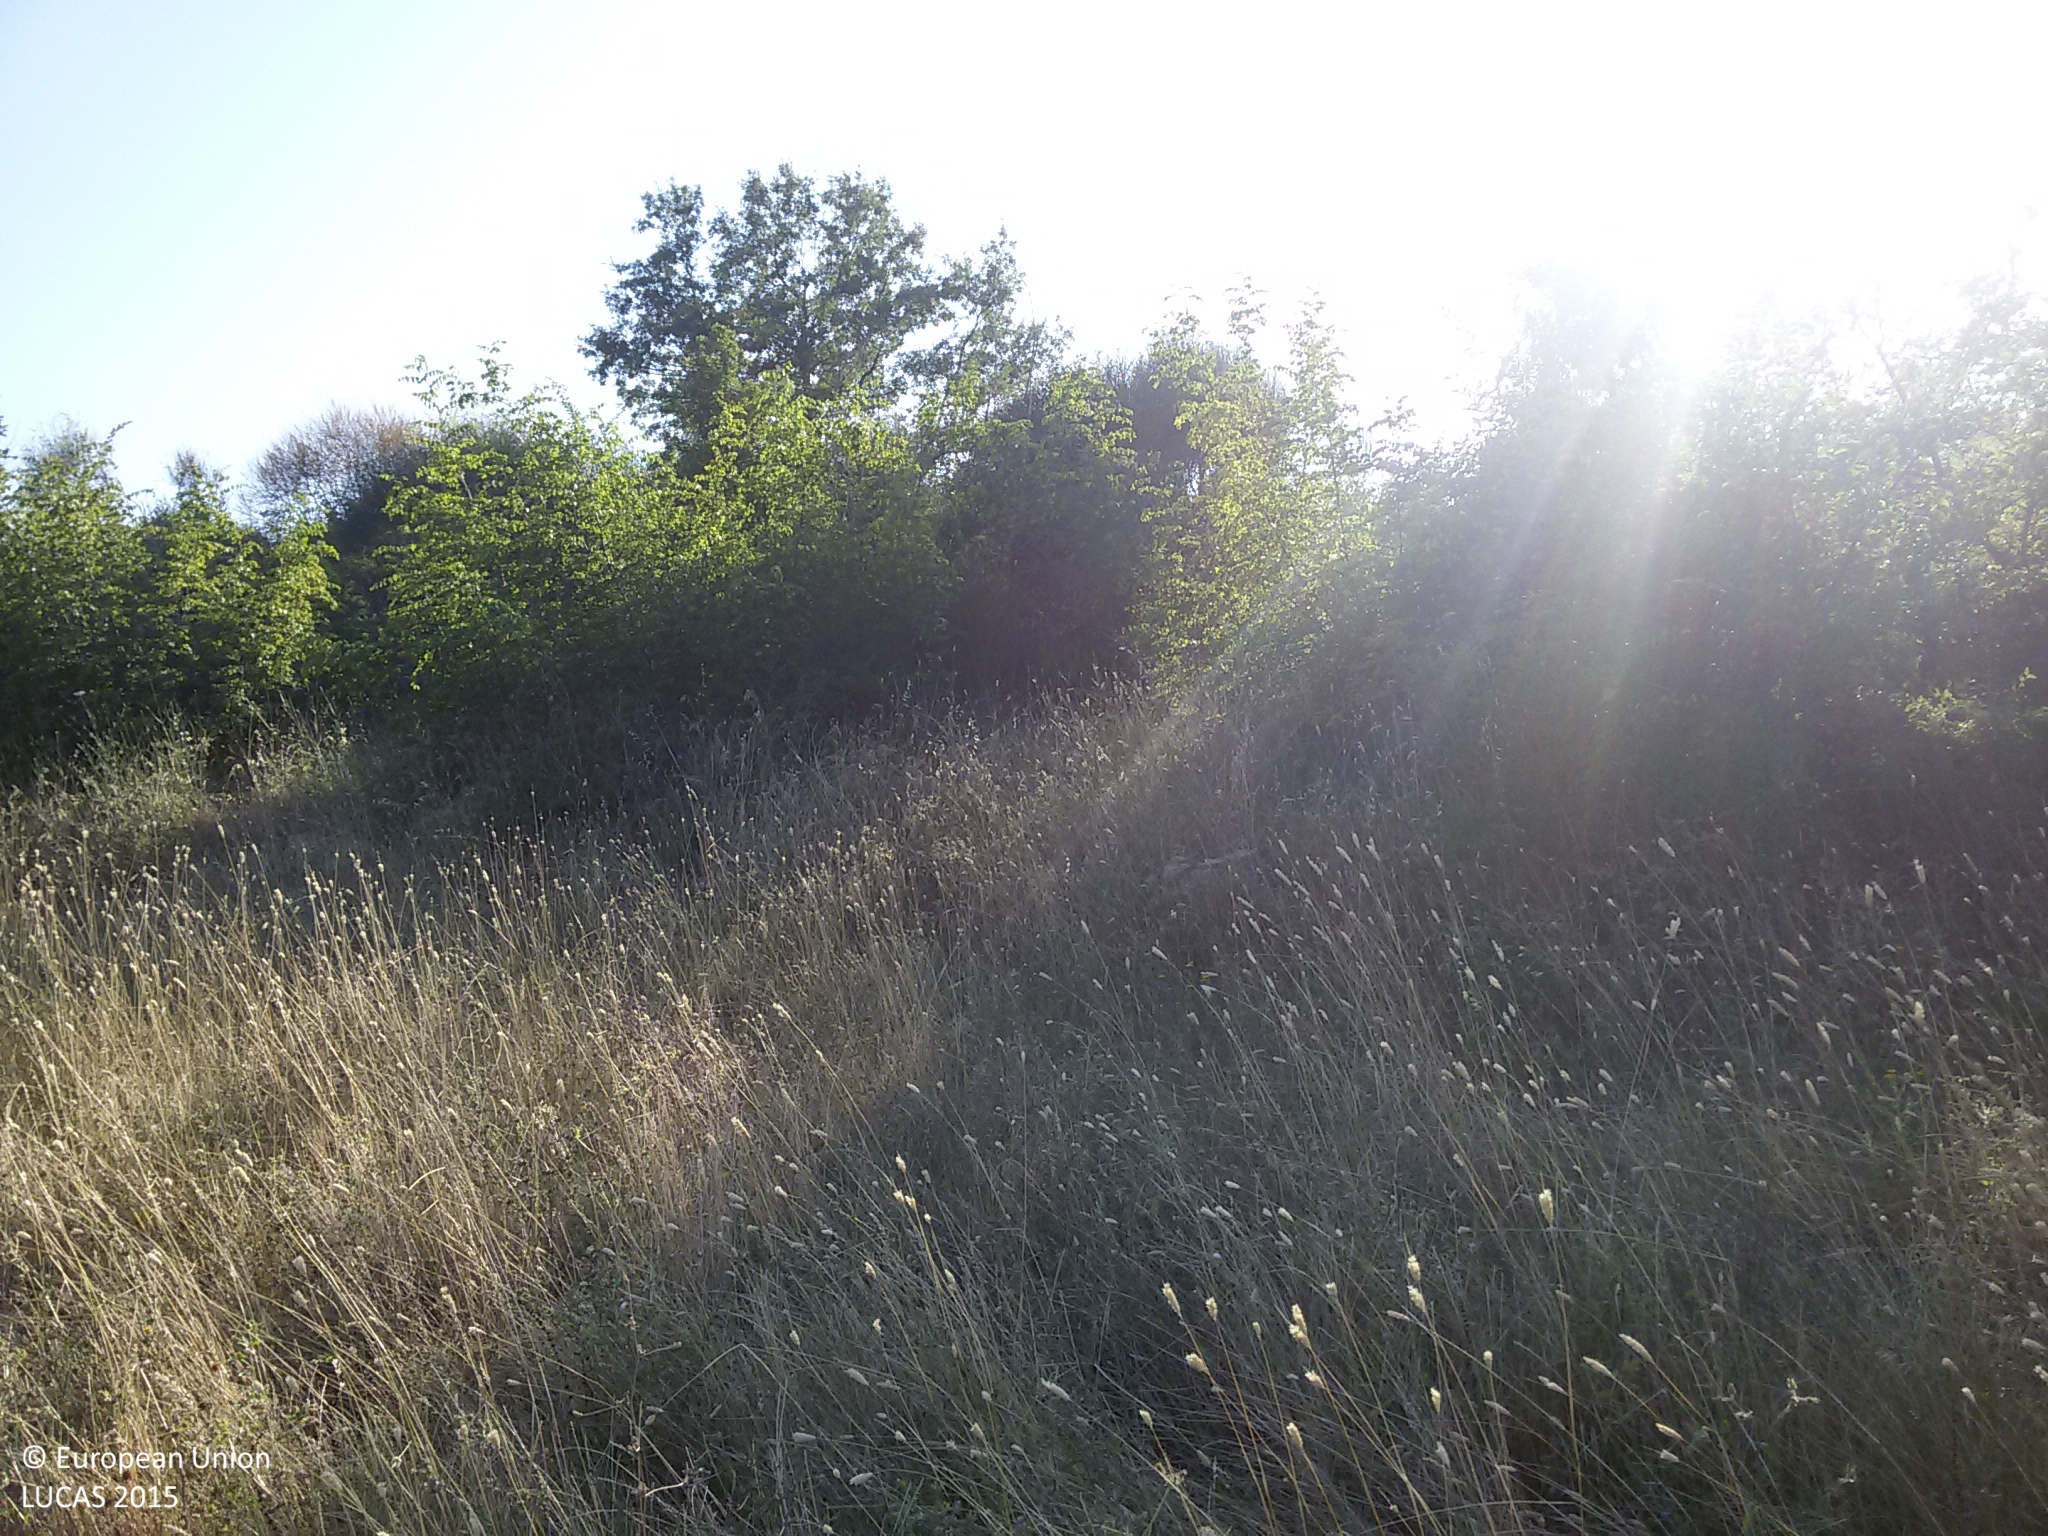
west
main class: Woodland
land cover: Broadleaved woodland
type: thermophilous deciduous forest
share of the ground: > 75 %
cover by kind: broadleaved forest trees 75 %, shrubs 20 %, herbaceous plants 5 %
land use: Forestry
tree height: > 5 m
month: July
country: IT
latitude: 42.7340
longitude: 11.4488
